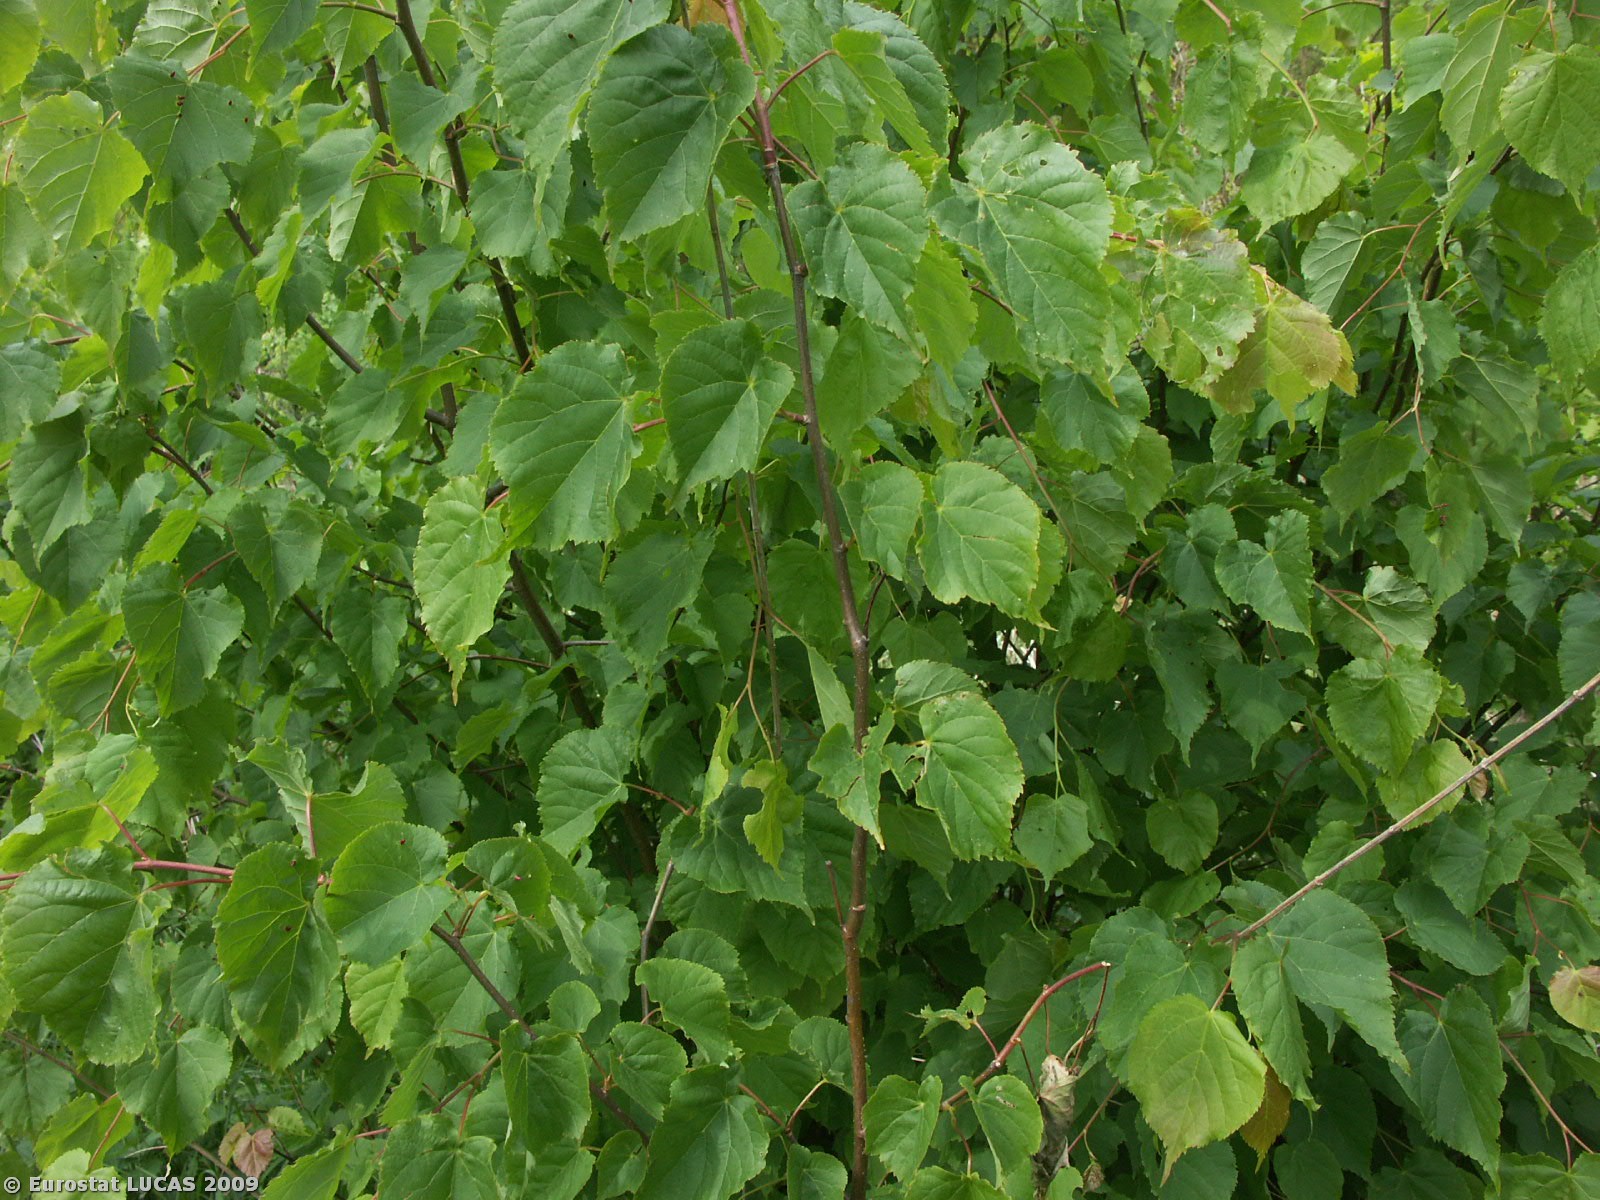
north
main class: Woodland
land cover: Broadleaved woodland
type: floodplain forest
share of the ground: > 75 %
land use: Forestry
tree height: > 5 m
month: May
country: CZ
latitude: 49.7068
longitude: 17.1517
